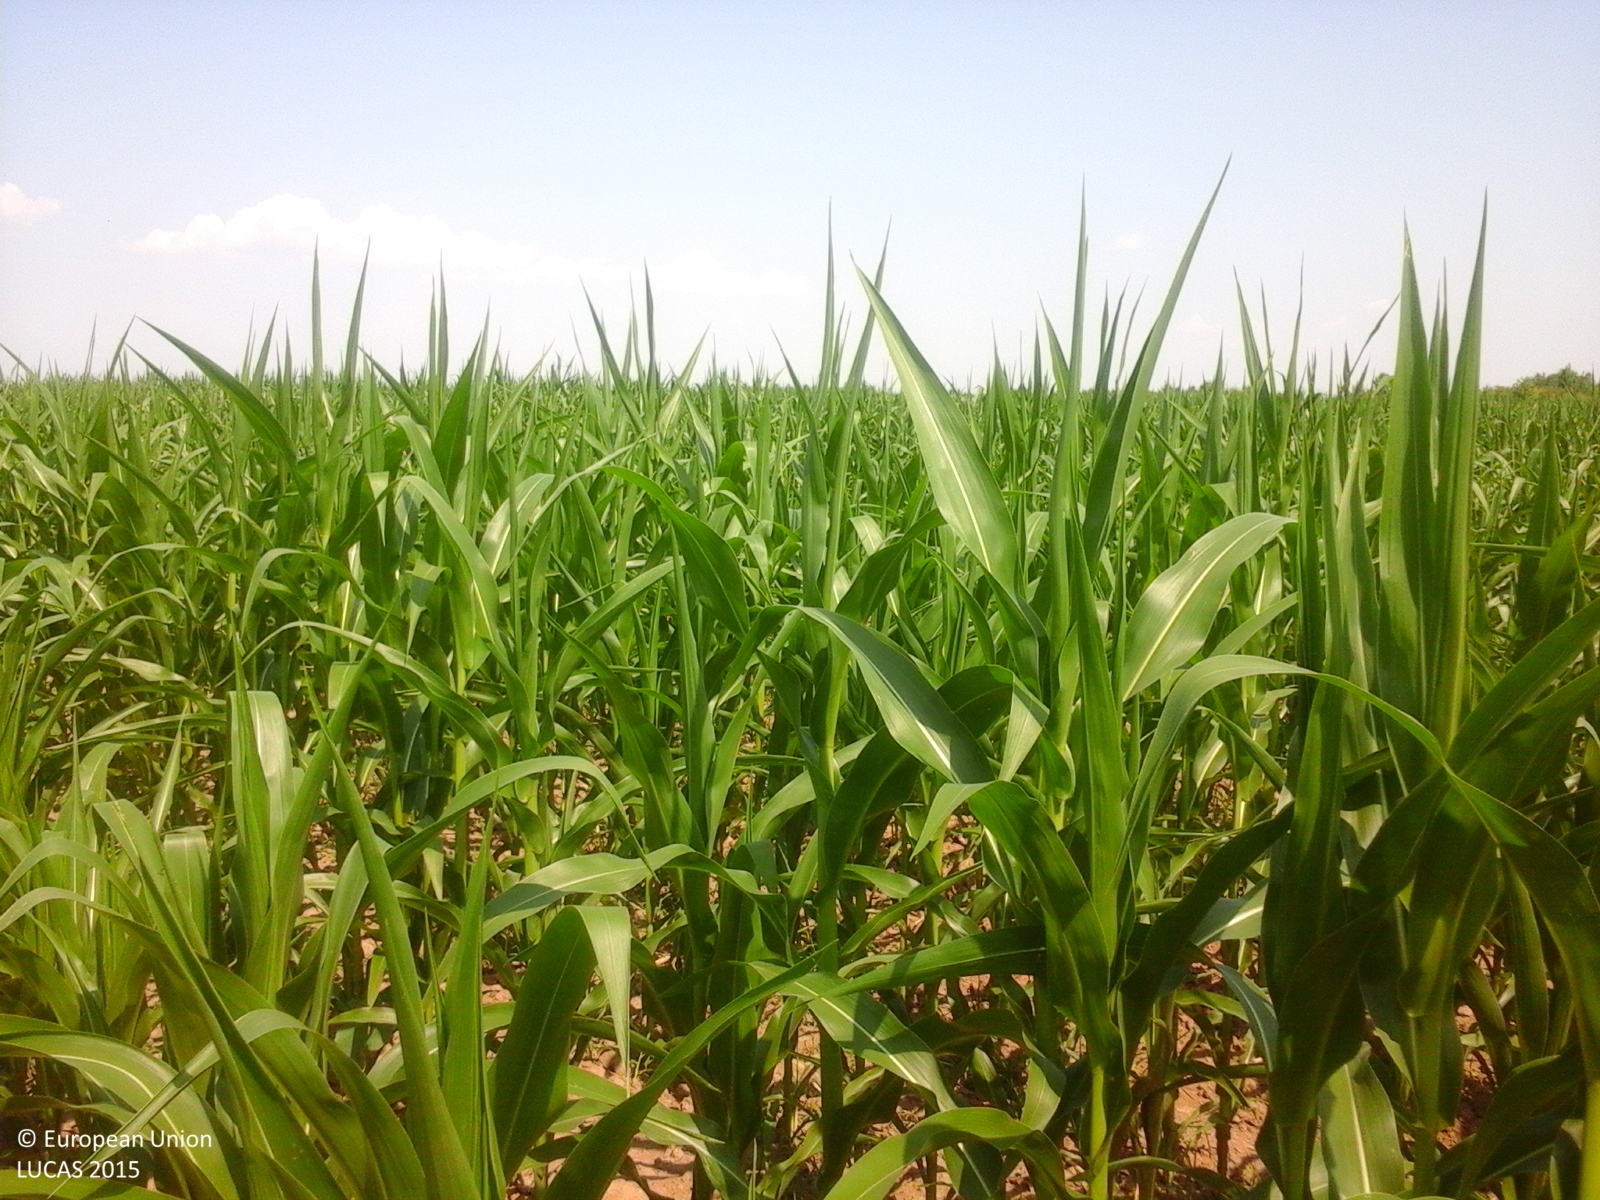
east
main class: Cropland
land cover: Maize
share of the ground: > 75 %
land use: Agriculture (excluding fallow land and kitchen gardens)
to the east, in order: Maize; Grass margins; Tracks; Grass margins; Oats; Spontaneously vegetated surfaces; Maize
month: July
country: RO
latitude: 44.7199
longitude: 24.7347
